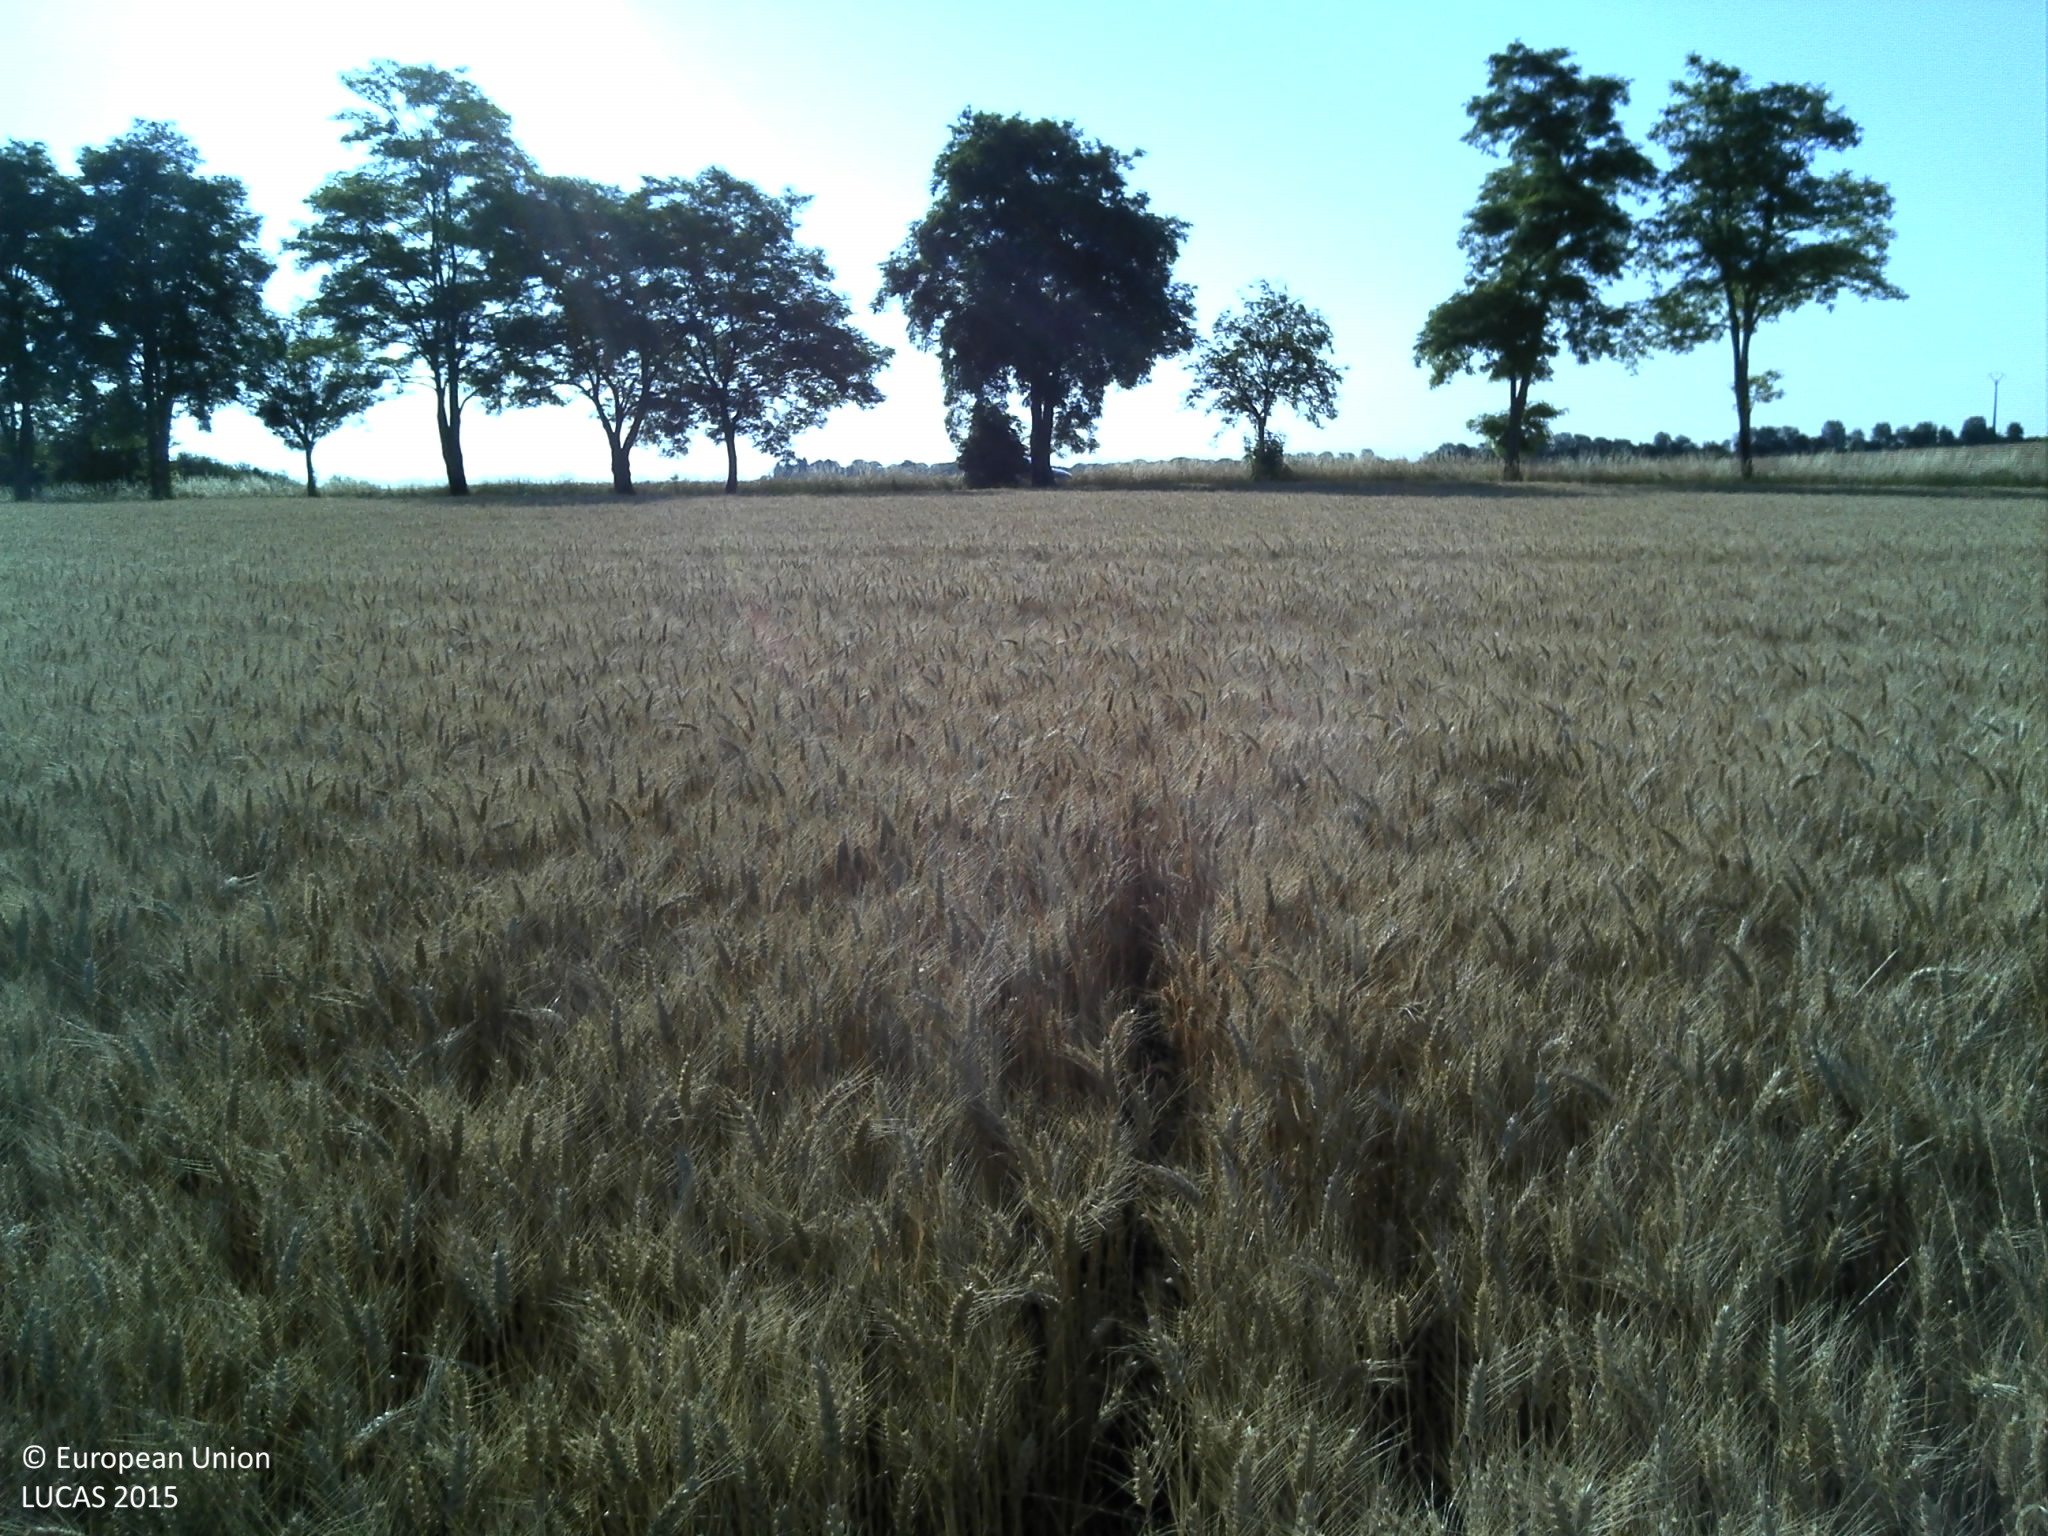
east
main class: Cropland
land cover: Durum wheat
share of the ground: > 75 %
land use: Agriculture (excluding fallow land and kitchen gardens)
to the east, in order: Durum wheat; Lines of trees; Tracks; Grass margins; Durum wheat
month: July
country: FR
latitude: 48.1863
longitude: 5.9785
